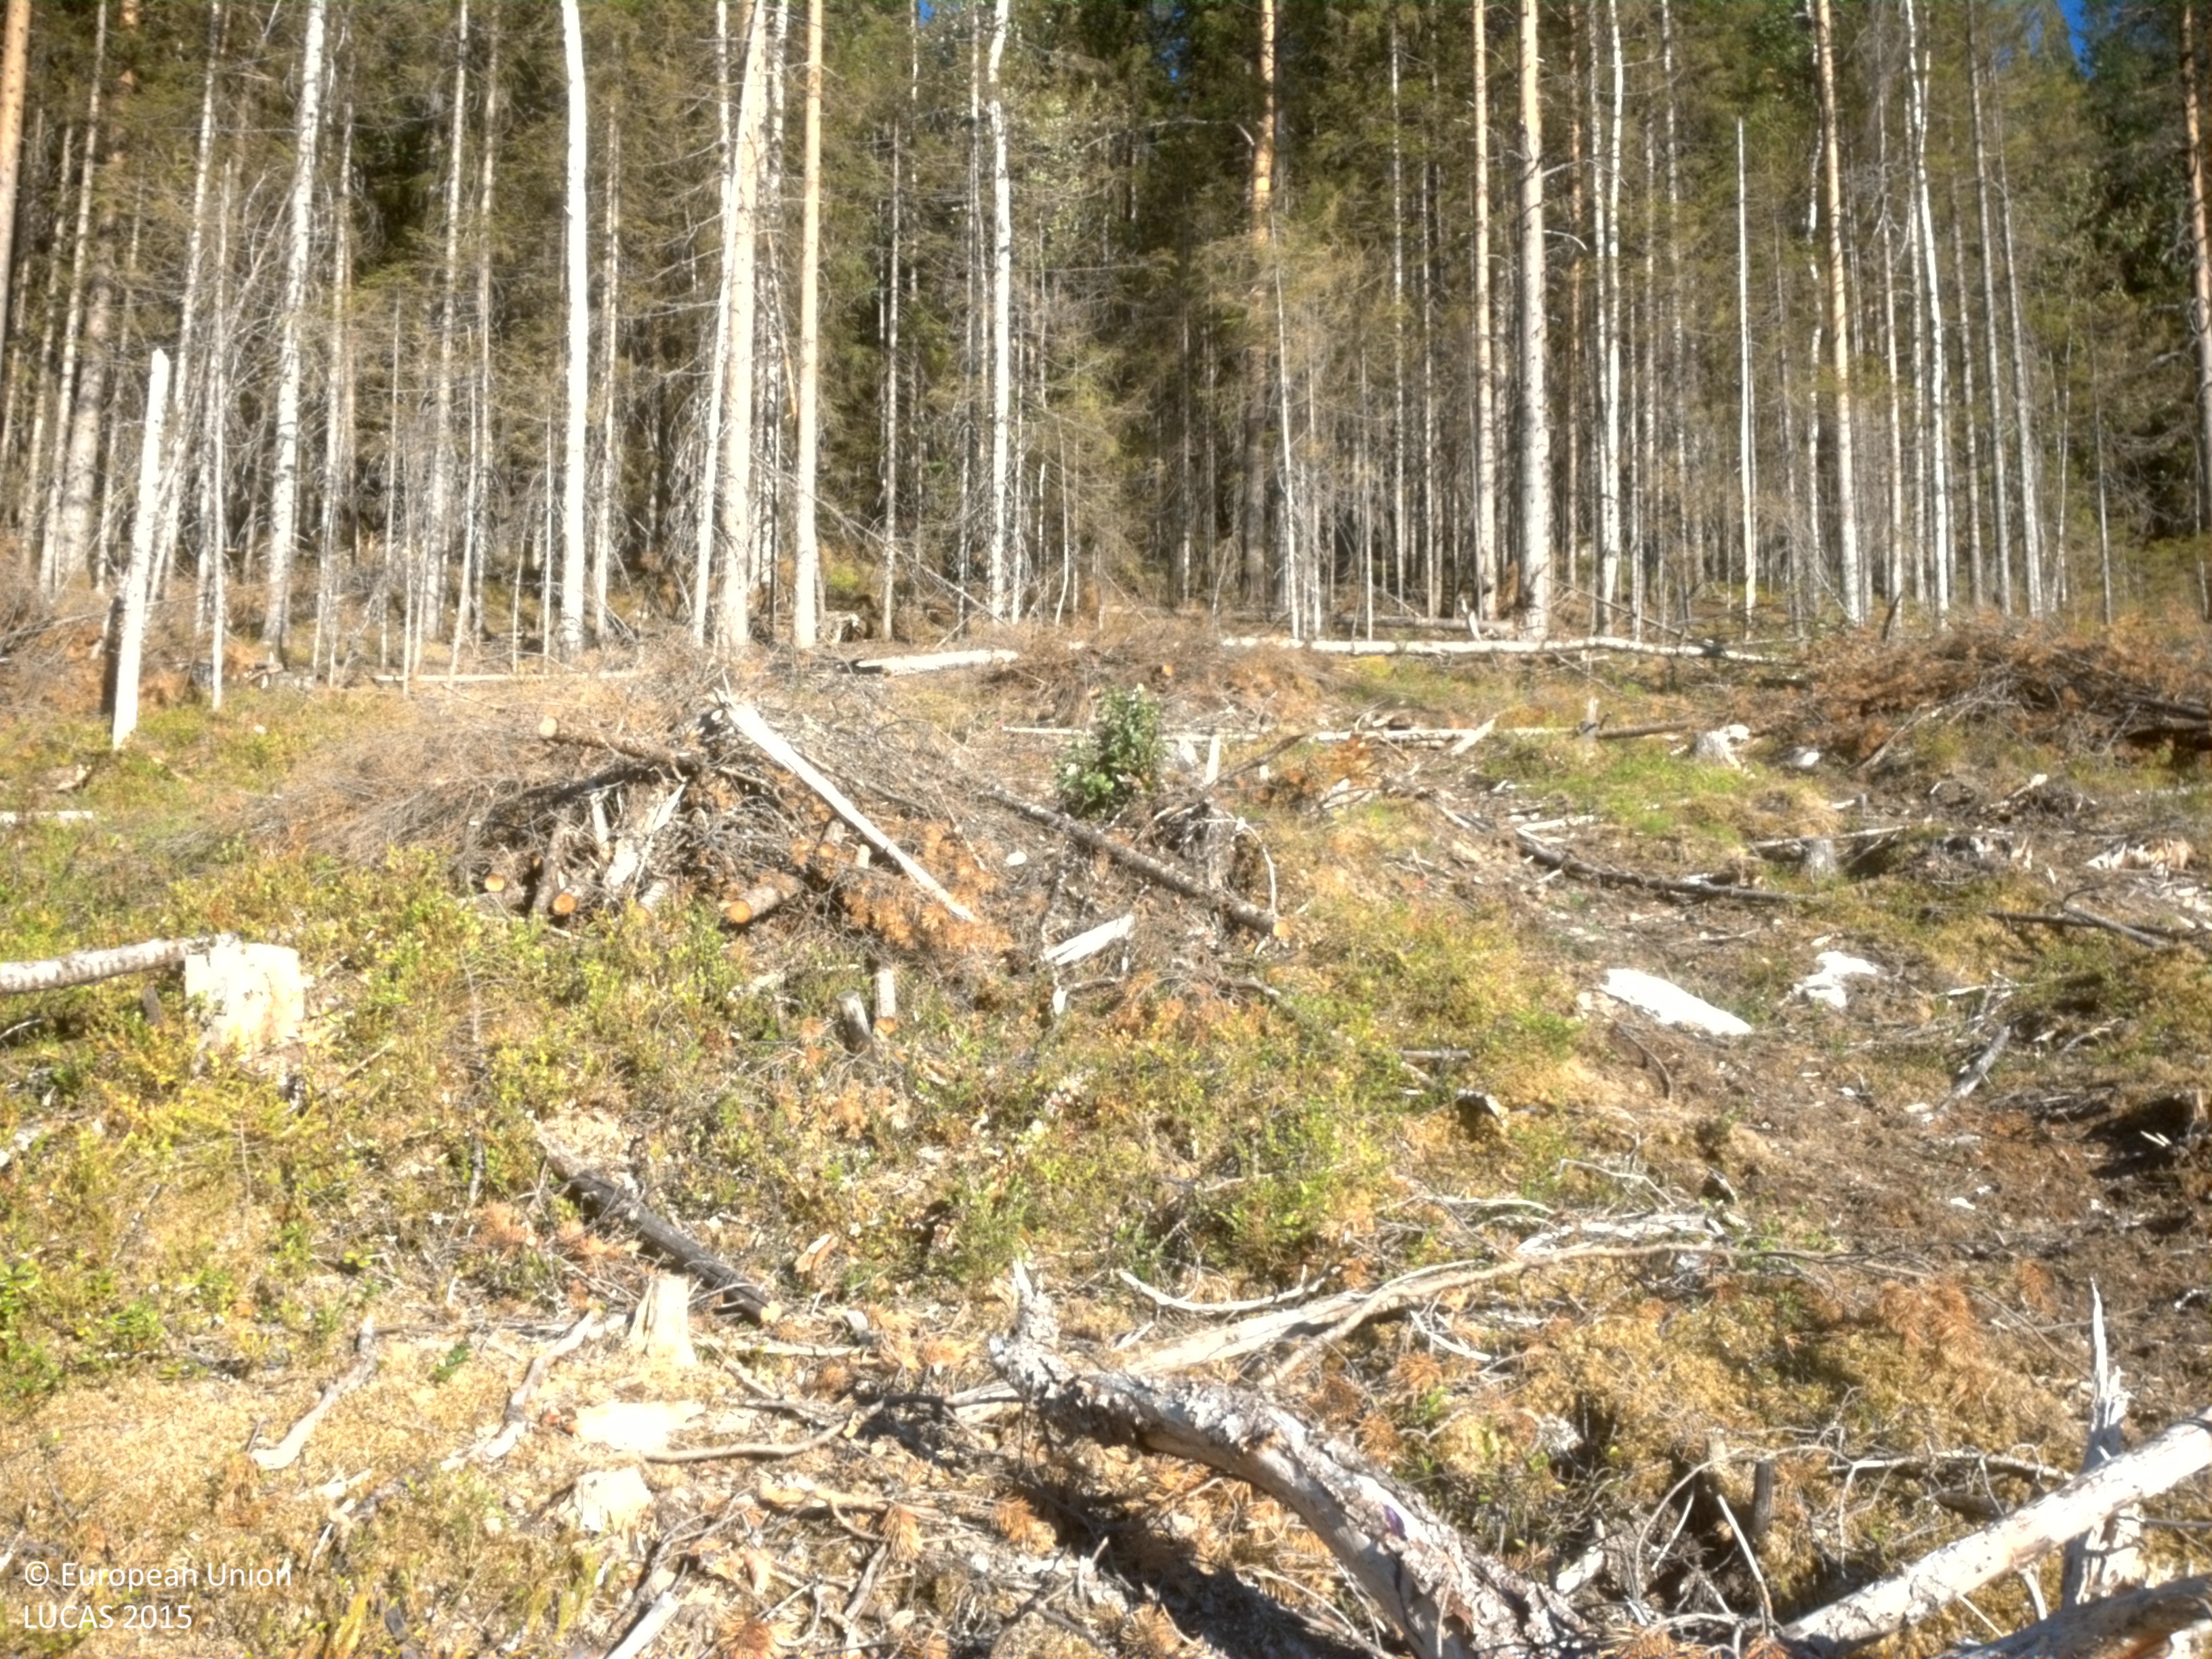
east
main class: Shrubland
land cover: Shrubland with sparse tree cover
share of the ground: > 75 %
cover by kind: shrubs 85 %, lichens and mosses 10 %, coniferous forest trees 5 %
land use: Forestry
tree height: > 5 m
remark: Clear cut
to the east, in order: Shrubland with sparse tree cover; Spruce dominated coniferous woodland
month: August
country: SE
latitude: 64.6275
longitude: 19.1092
